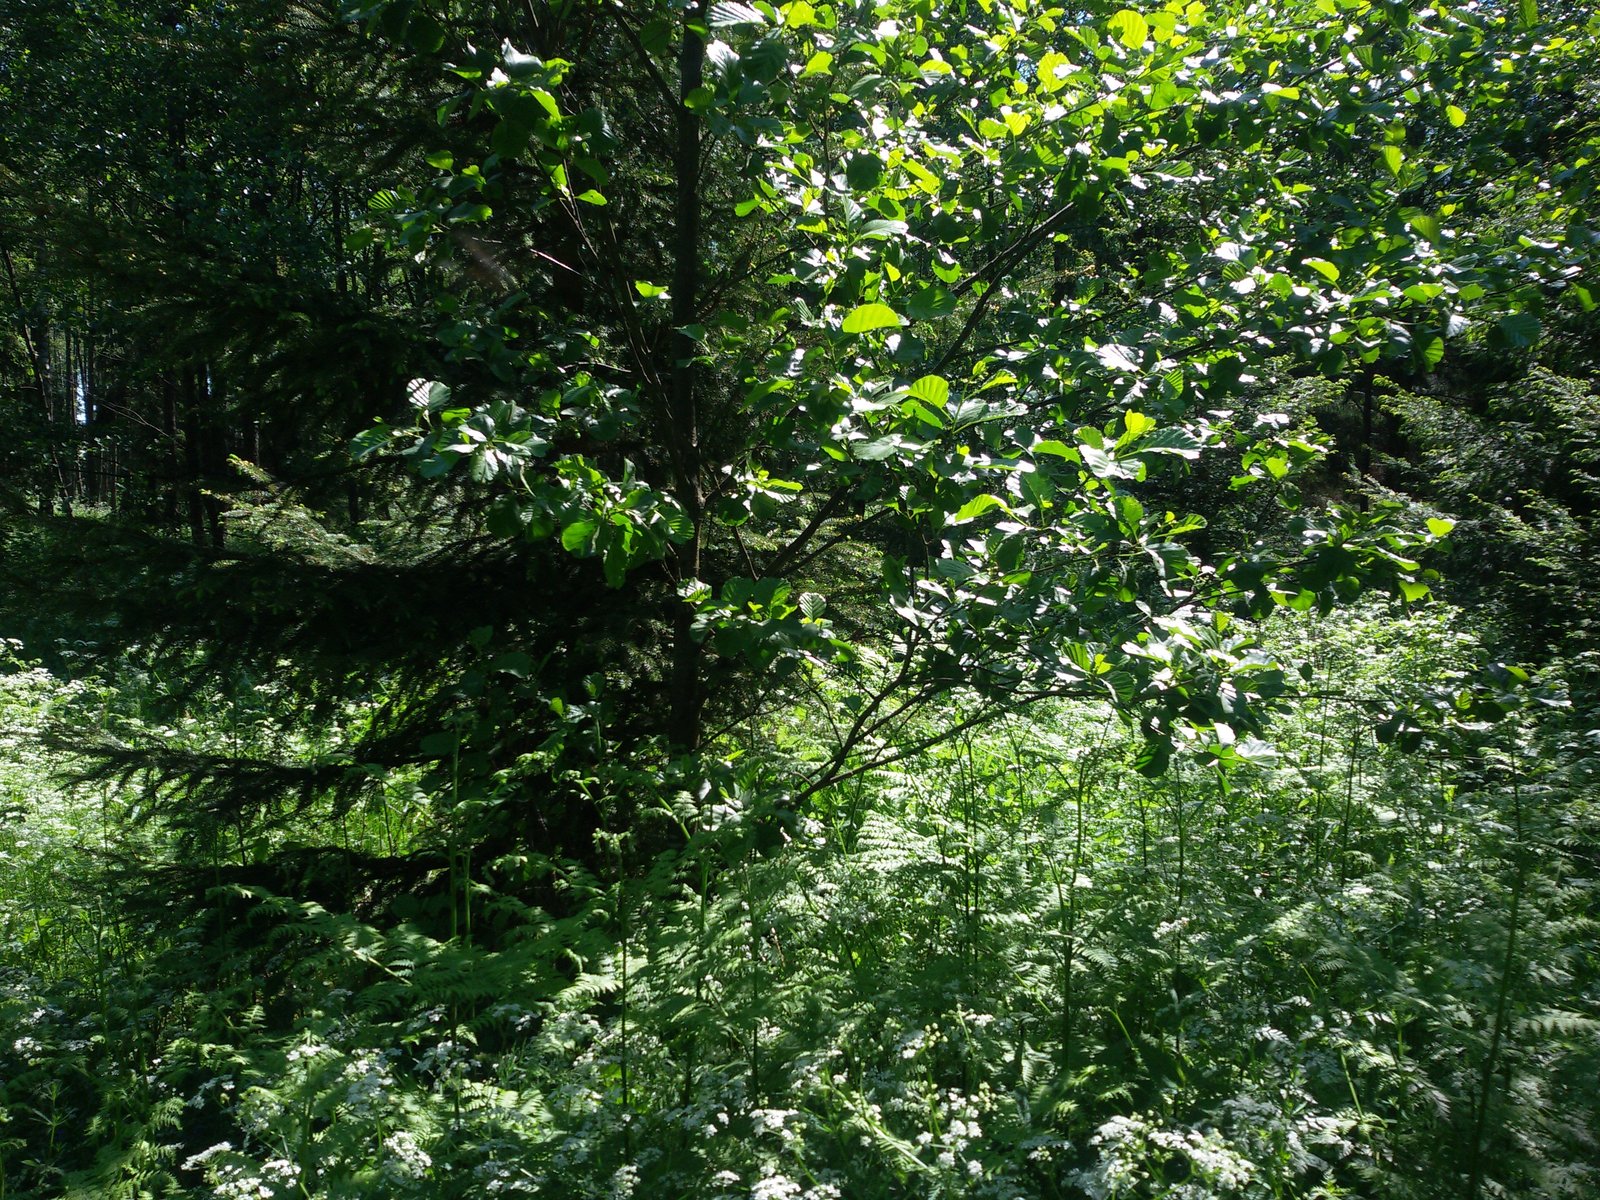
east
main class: Woodland
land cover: Broadleaved woodland
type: mesophytic deciduous forest
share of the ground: > 75 %
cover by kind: broadleaved forest trees 85 %, coniferous forest trees 5 %, shrubs 5 %, herbaceous plants 5 %
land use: Forestry
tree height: > 5 m
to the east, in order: Broadleaved woodland; Ditches and canals; Broadleaved woodland; Pine dominated coniferous woodland; Tracks; Grassland with sparse tree/shrub cover
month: June
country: PL
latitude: 53.4860
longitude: 21.5190
